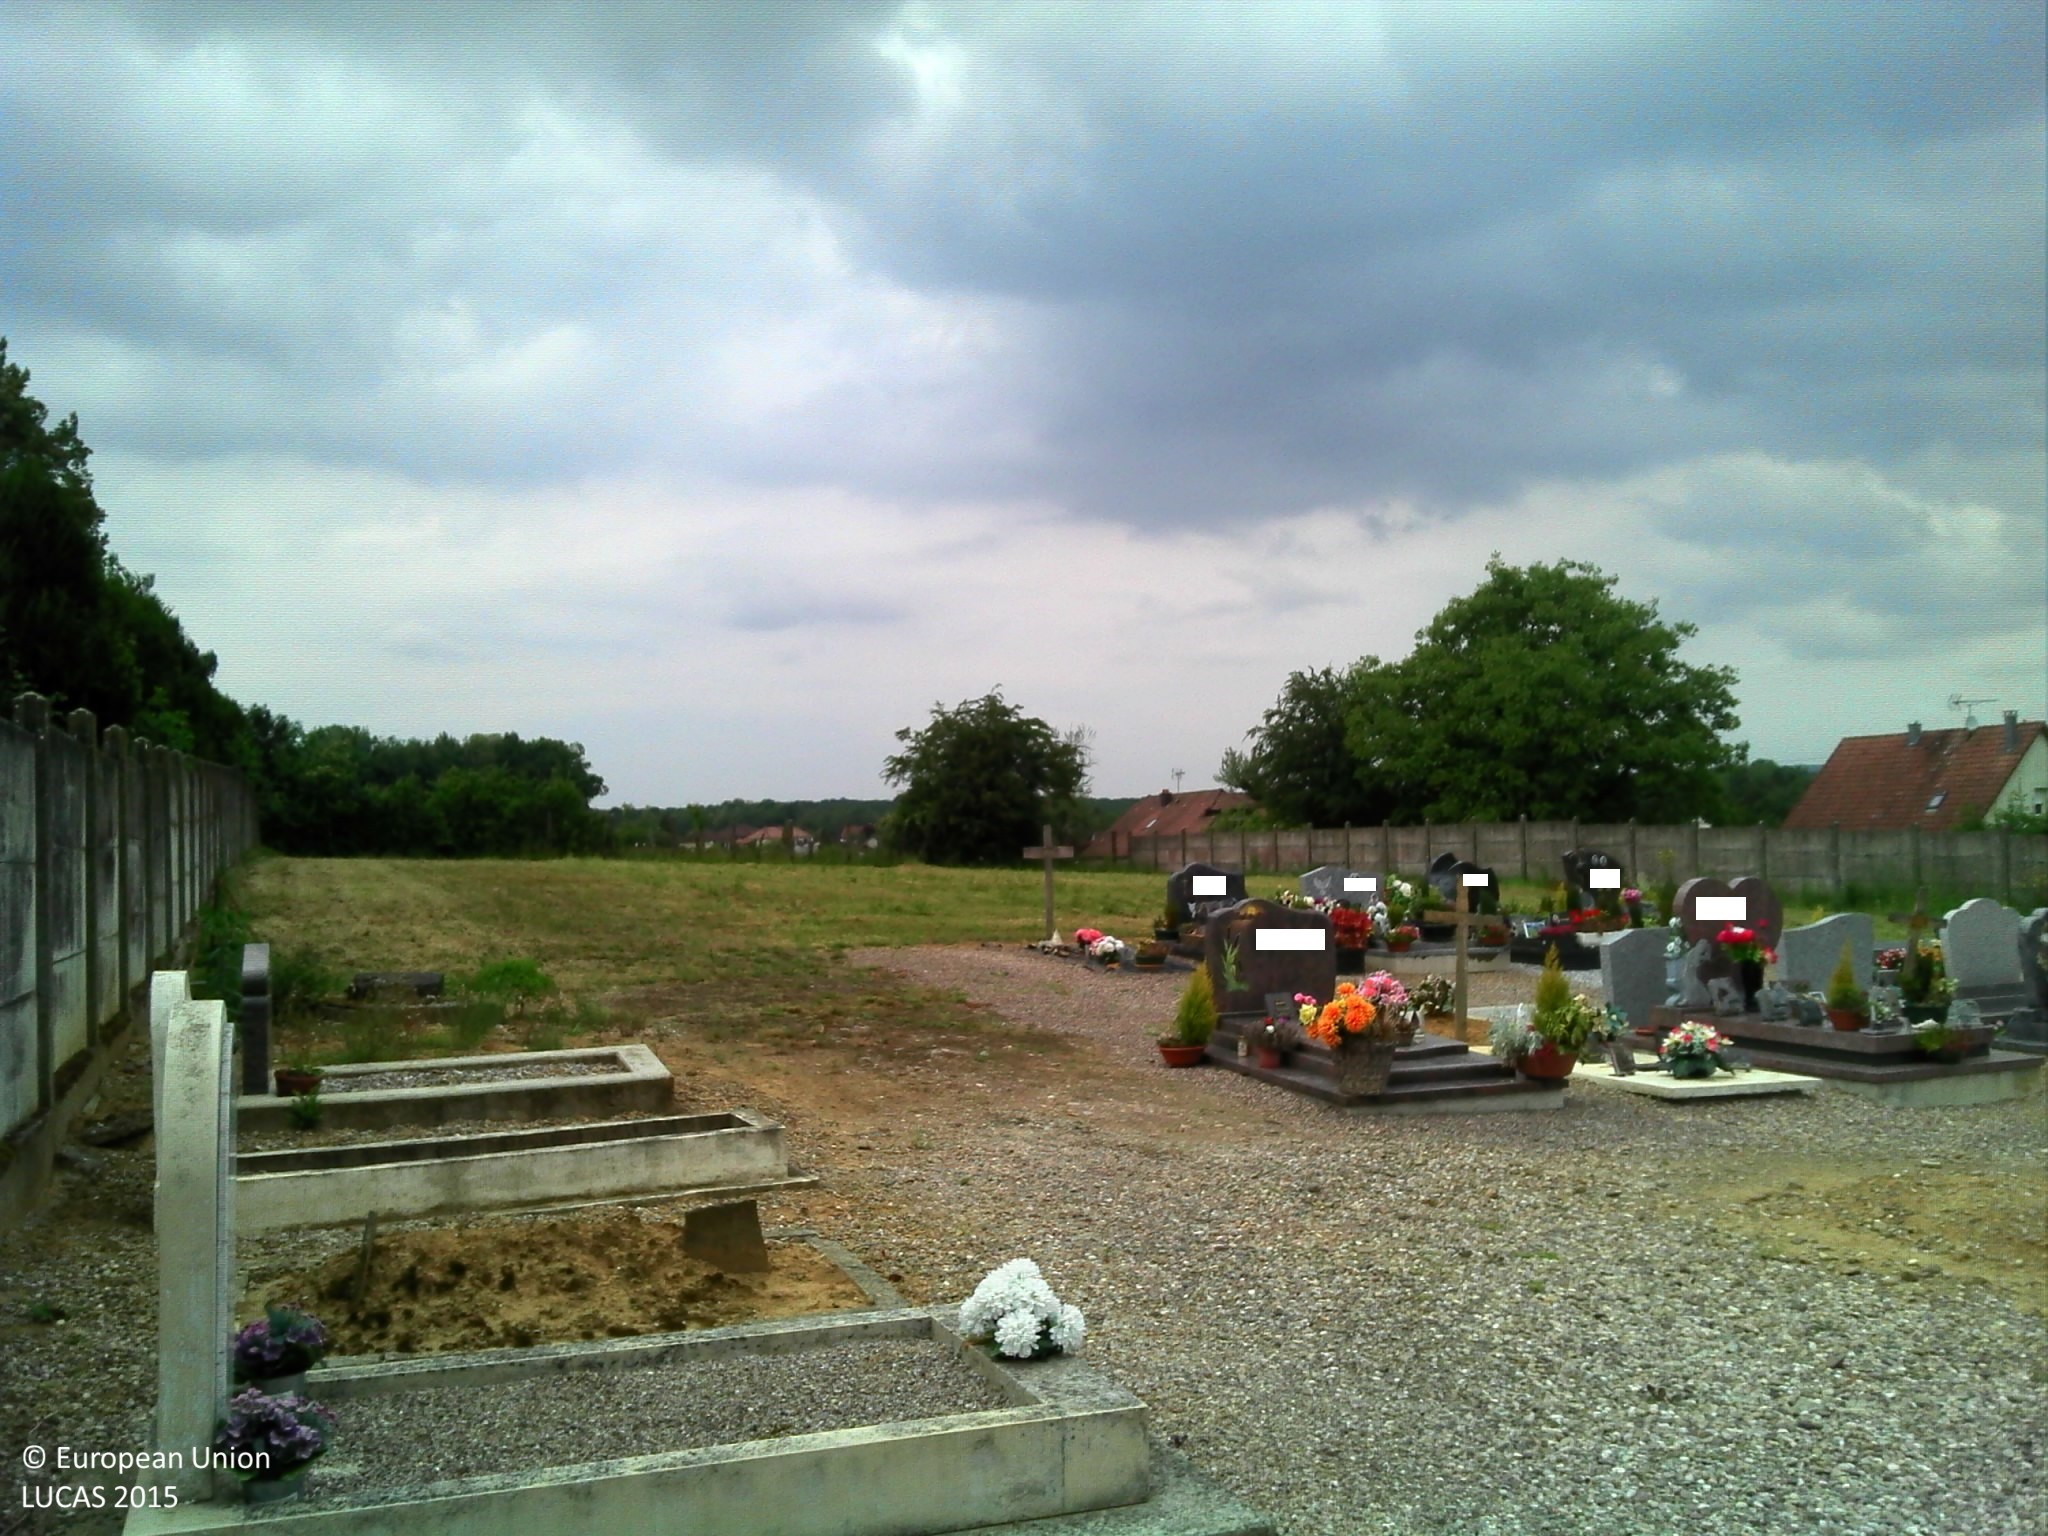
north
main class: Grassland
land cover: Grassland with sparse tree/shrub cover
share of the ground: > 75 %
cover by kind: herbaceous plants 95 %, broadleaved forest trees 5 %
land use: Agriculture (excluding fallow land and kitchen gardens)
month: May
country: FR
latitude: 47.8902
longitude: 6.2695
